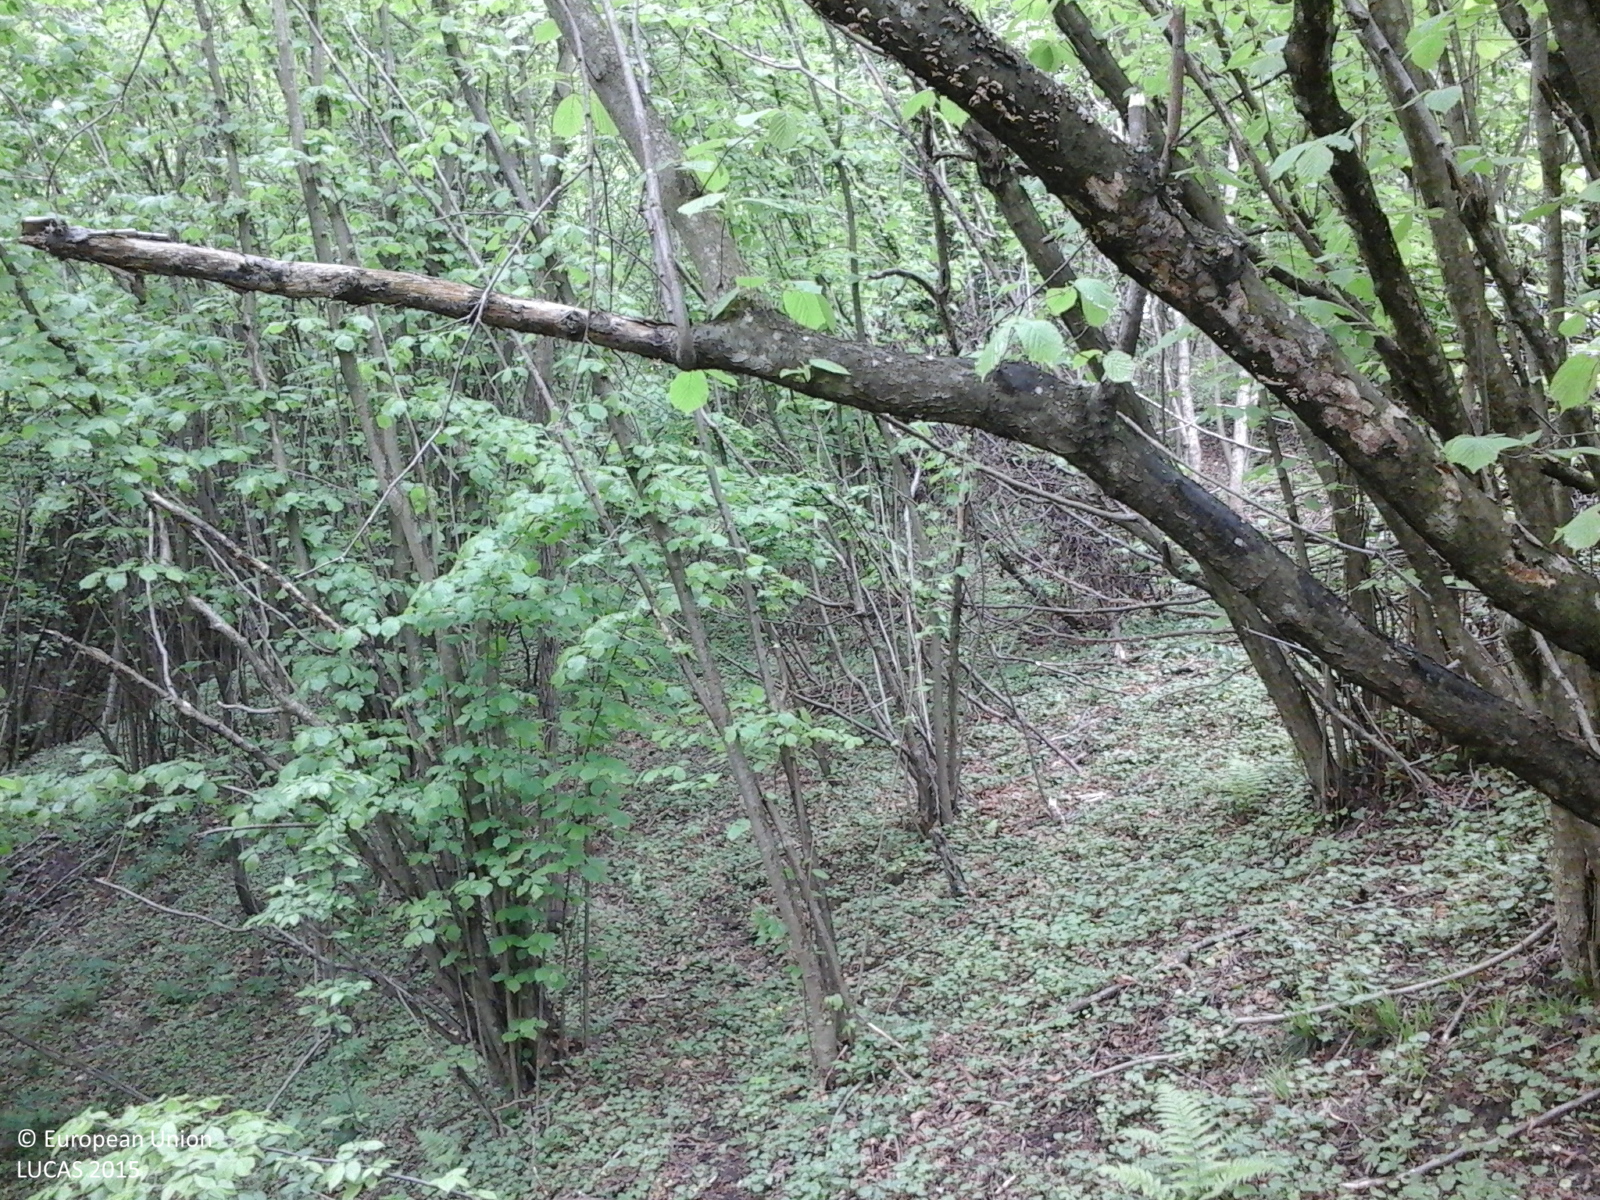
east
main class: Woodland
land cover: Broadleaved woodland
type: floodplain forest
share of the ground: > 75 %
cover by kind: broadleaved forest trees 100 %
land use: Forestry
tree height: > 5 m
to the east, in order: Broadleaved woodland; Rivers and streams; Broadleaved woodland; Grassland with sparse tree/shrub cover
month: May
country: RO
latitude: 45.9037
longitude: 25.9042
